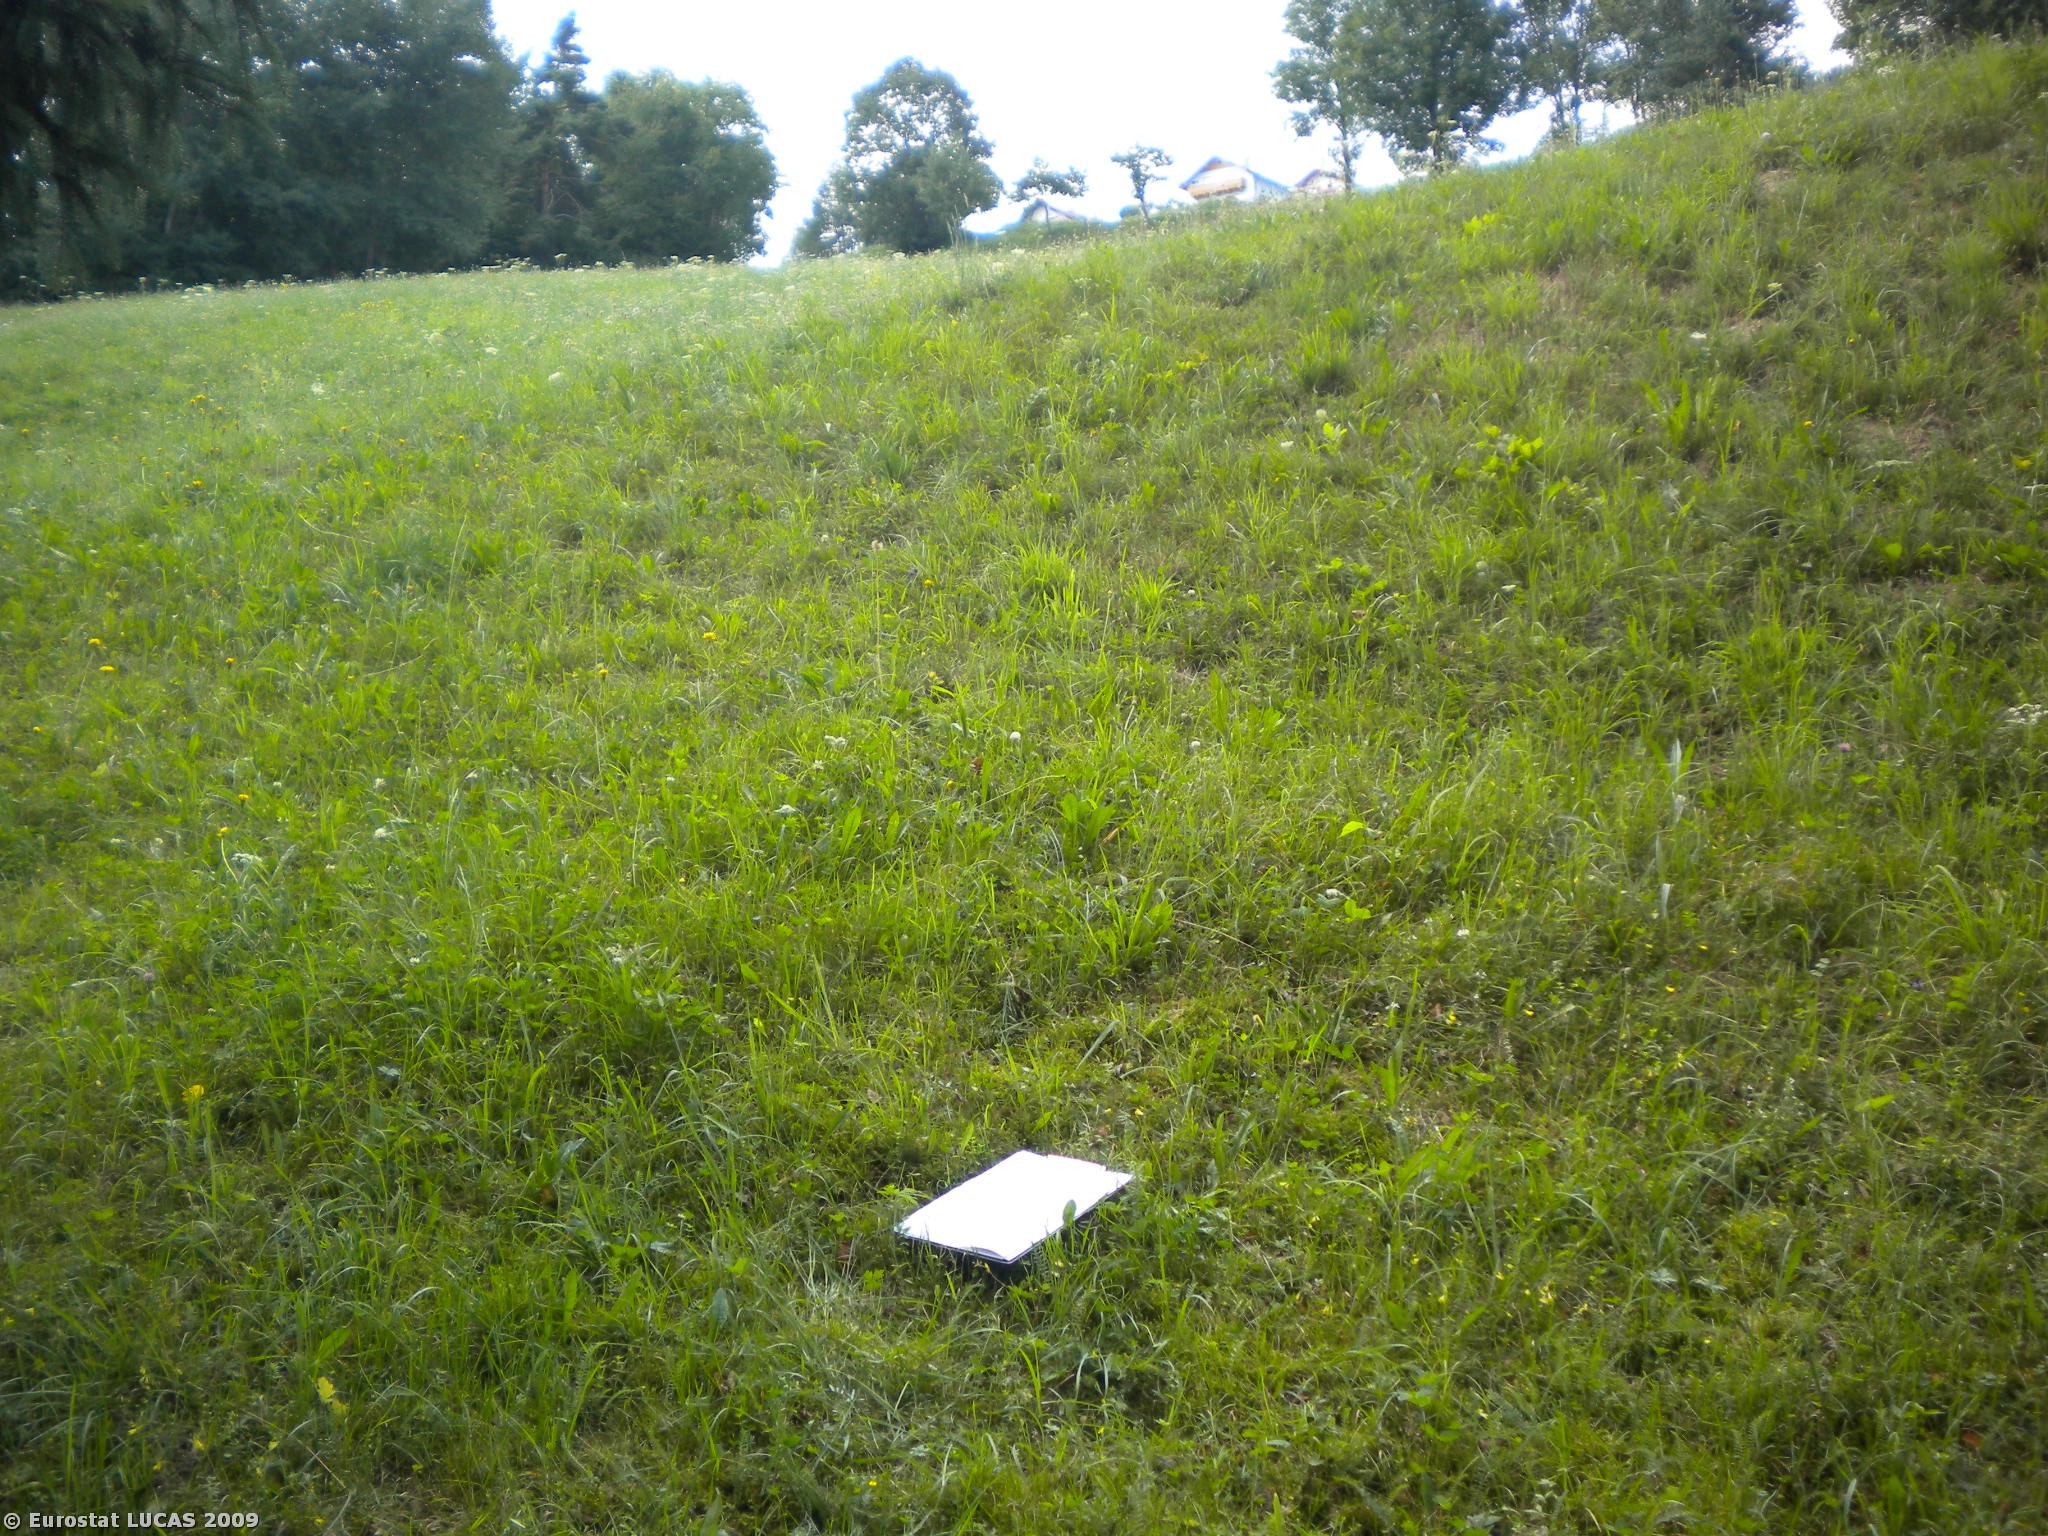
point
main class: Grassland
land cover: Grassland without tree/shrub cover
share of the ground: > 75 %
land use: Agriculture (excluding fallow land and kitchen gardens)
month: August
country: AT
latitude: 46.8357
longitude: 13.4719
